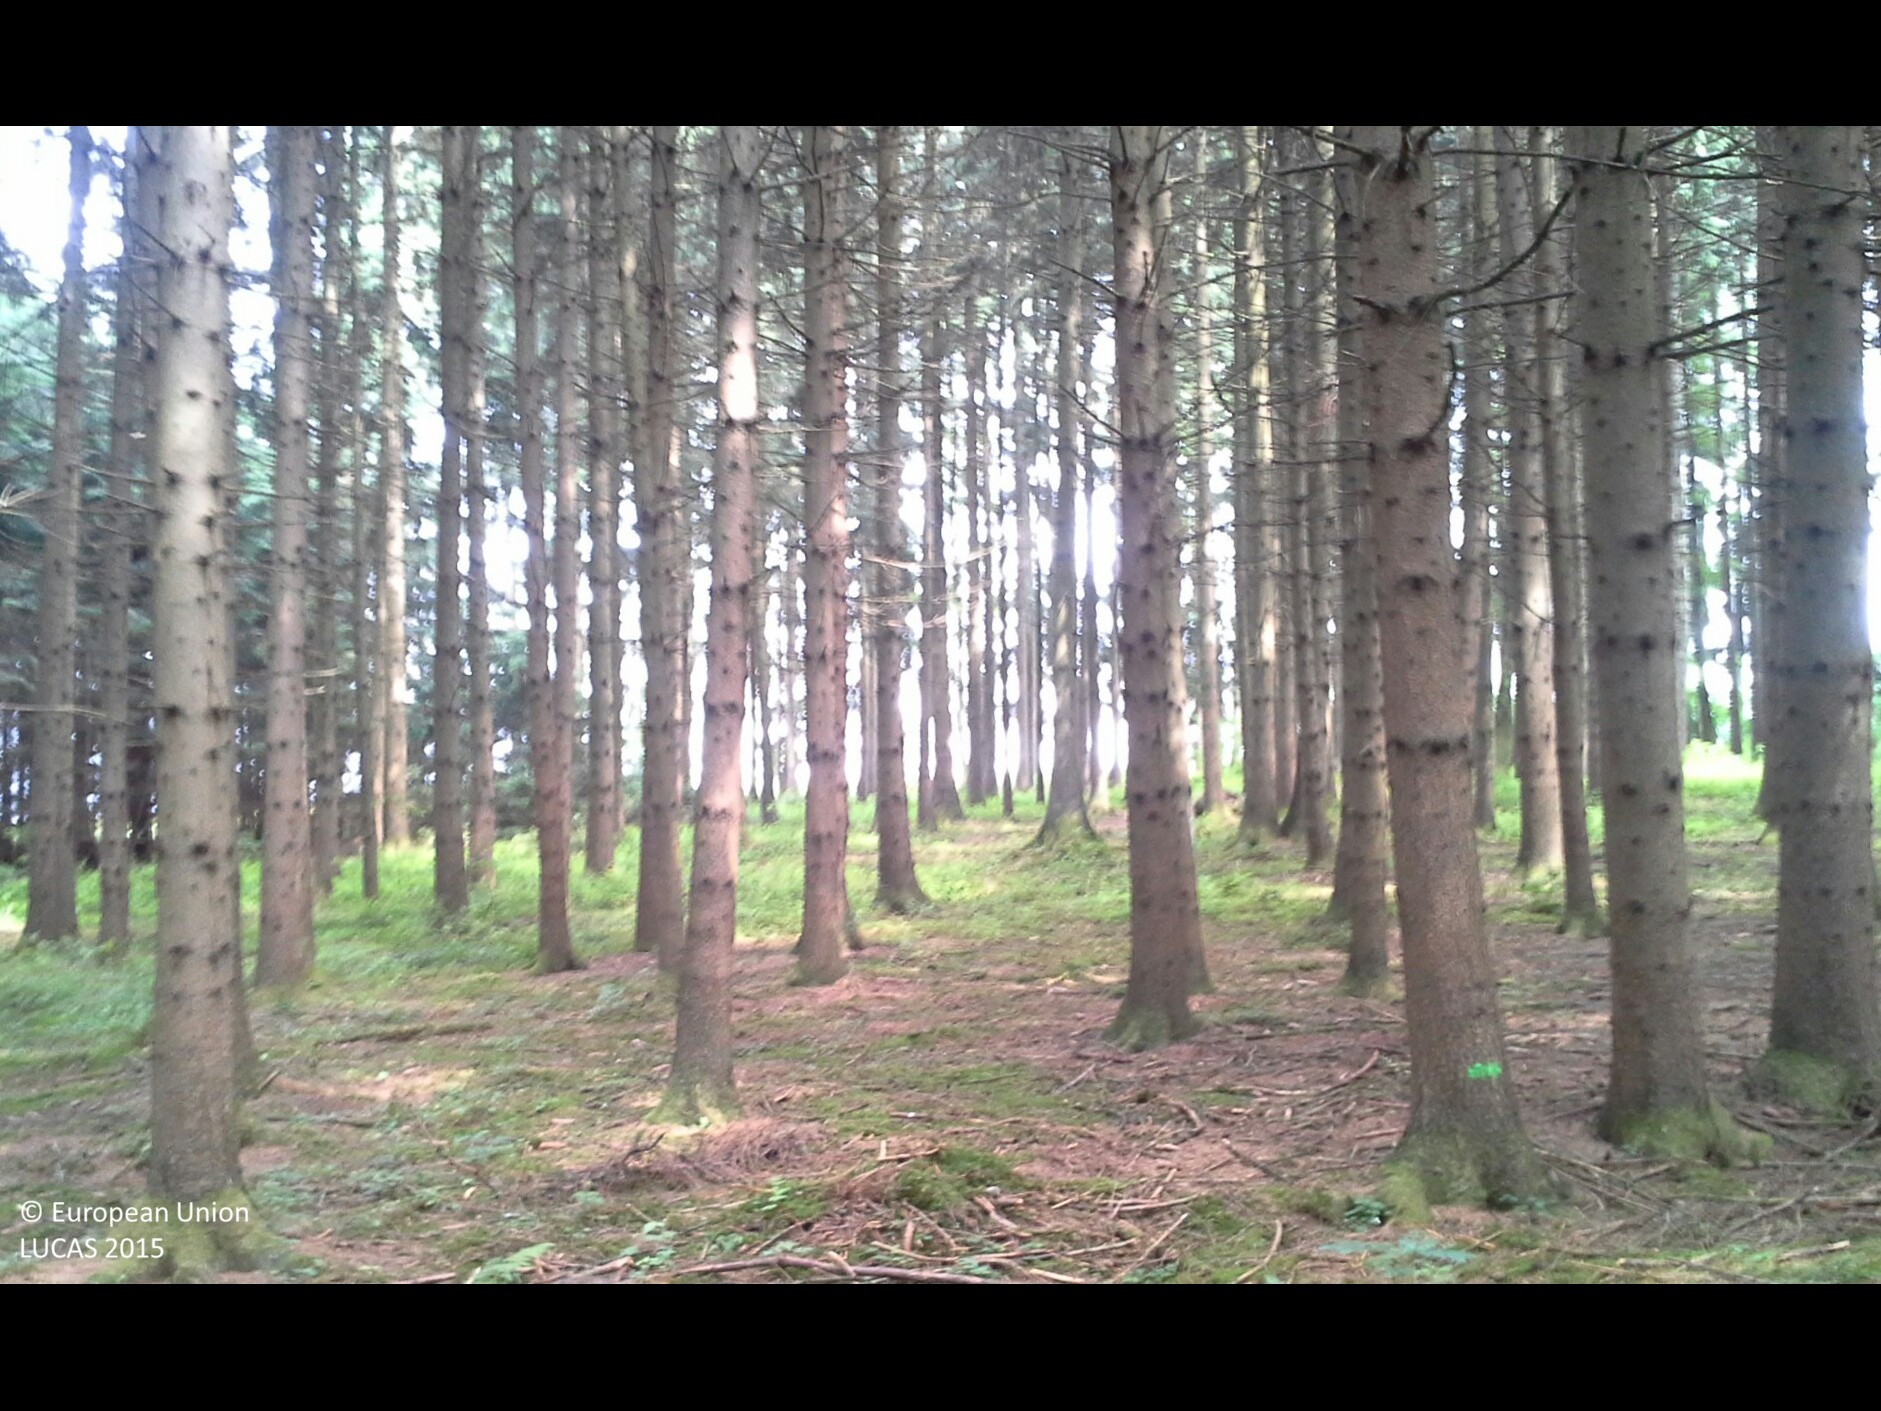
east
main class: Woodland
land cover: Spruce dominated coniferous woodland
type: hemiboreal forest and nemoral coniferous forest and mixed broadleaved-coniferous forest
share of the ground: > 75 %
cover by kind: coniferous forest trees 100 %
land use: Forestry
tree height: > 5 m
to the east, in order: Spruce dominated coniferous woodland; Temporary grasslands; Fences; Other fruit trees and berries
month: June
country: AT
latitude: 48.0663
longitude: 14.3345
